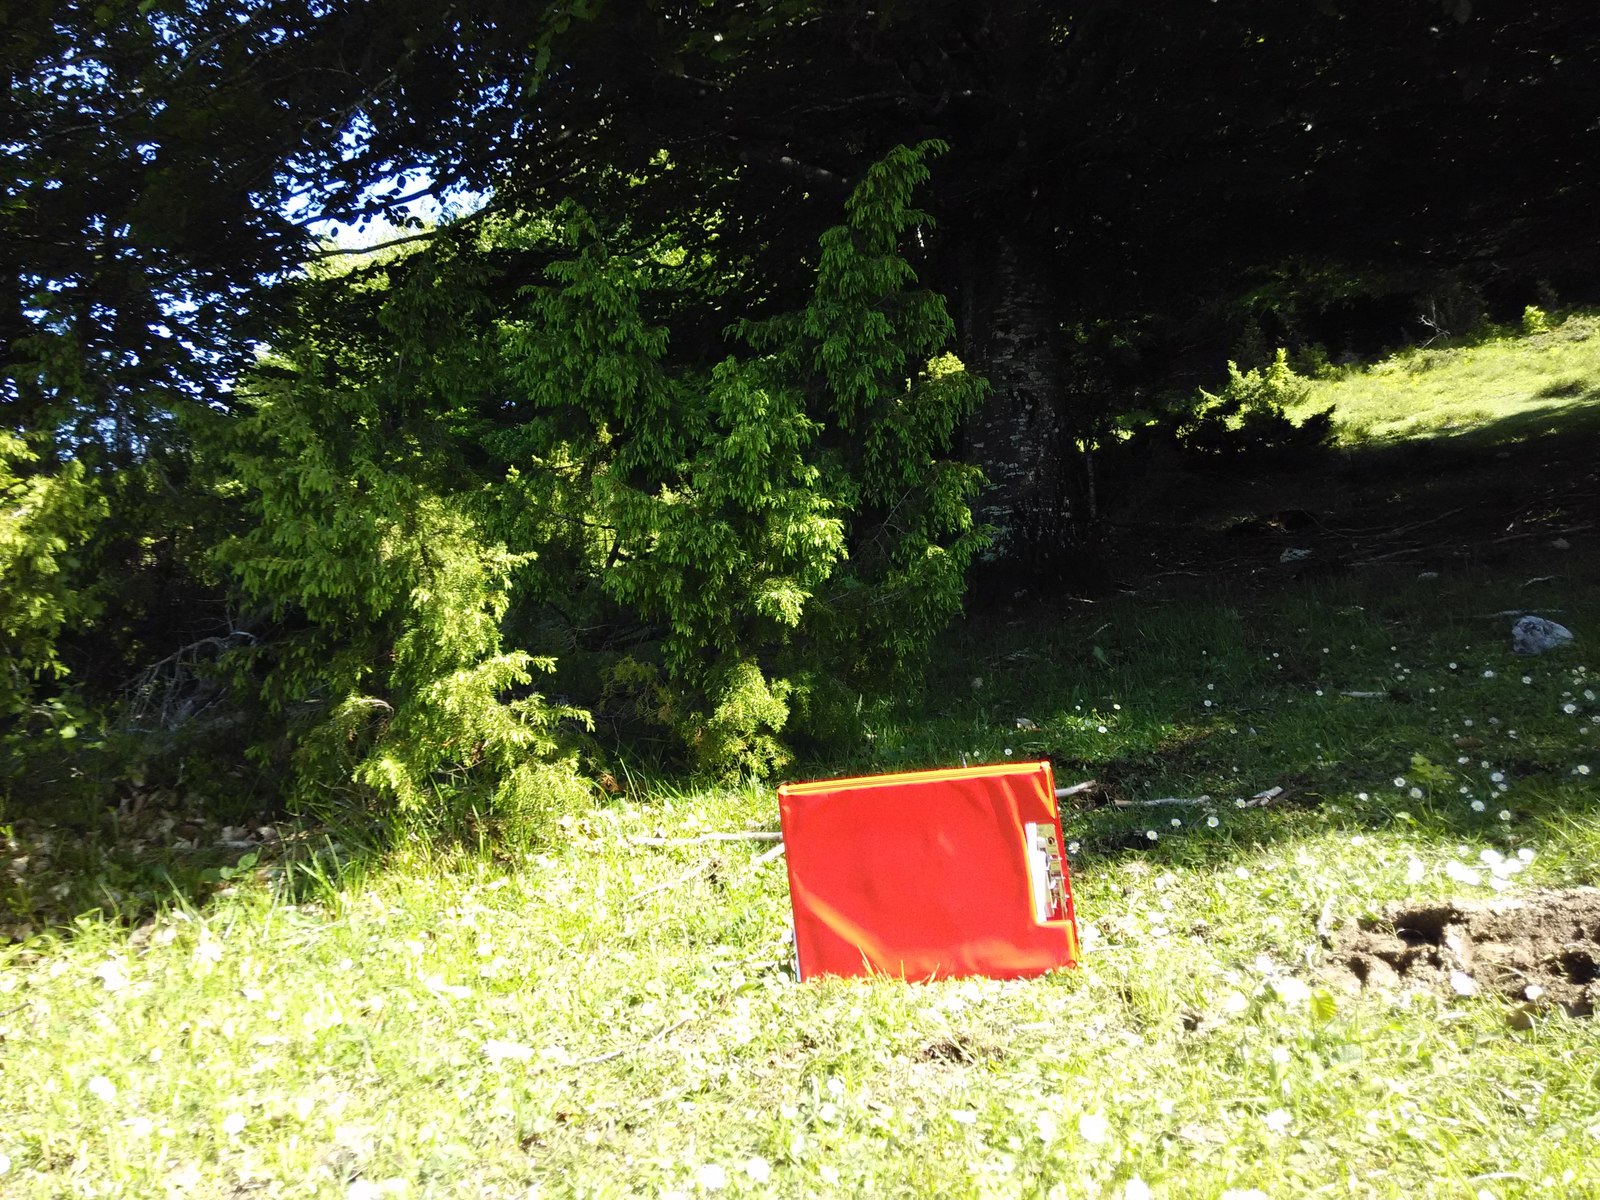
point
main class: Woodland
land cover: Broadleaved woodland
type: beech forest
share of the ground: 50 - 75 %
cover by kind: broadleaved forest trees 60 %, herbaceous plants 20 %, coniferous forest trees 10 %, shrubs 10 %
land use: Forestry
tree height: > 5 m
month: May
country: ES
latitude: 42.7348
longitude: -2.4944
